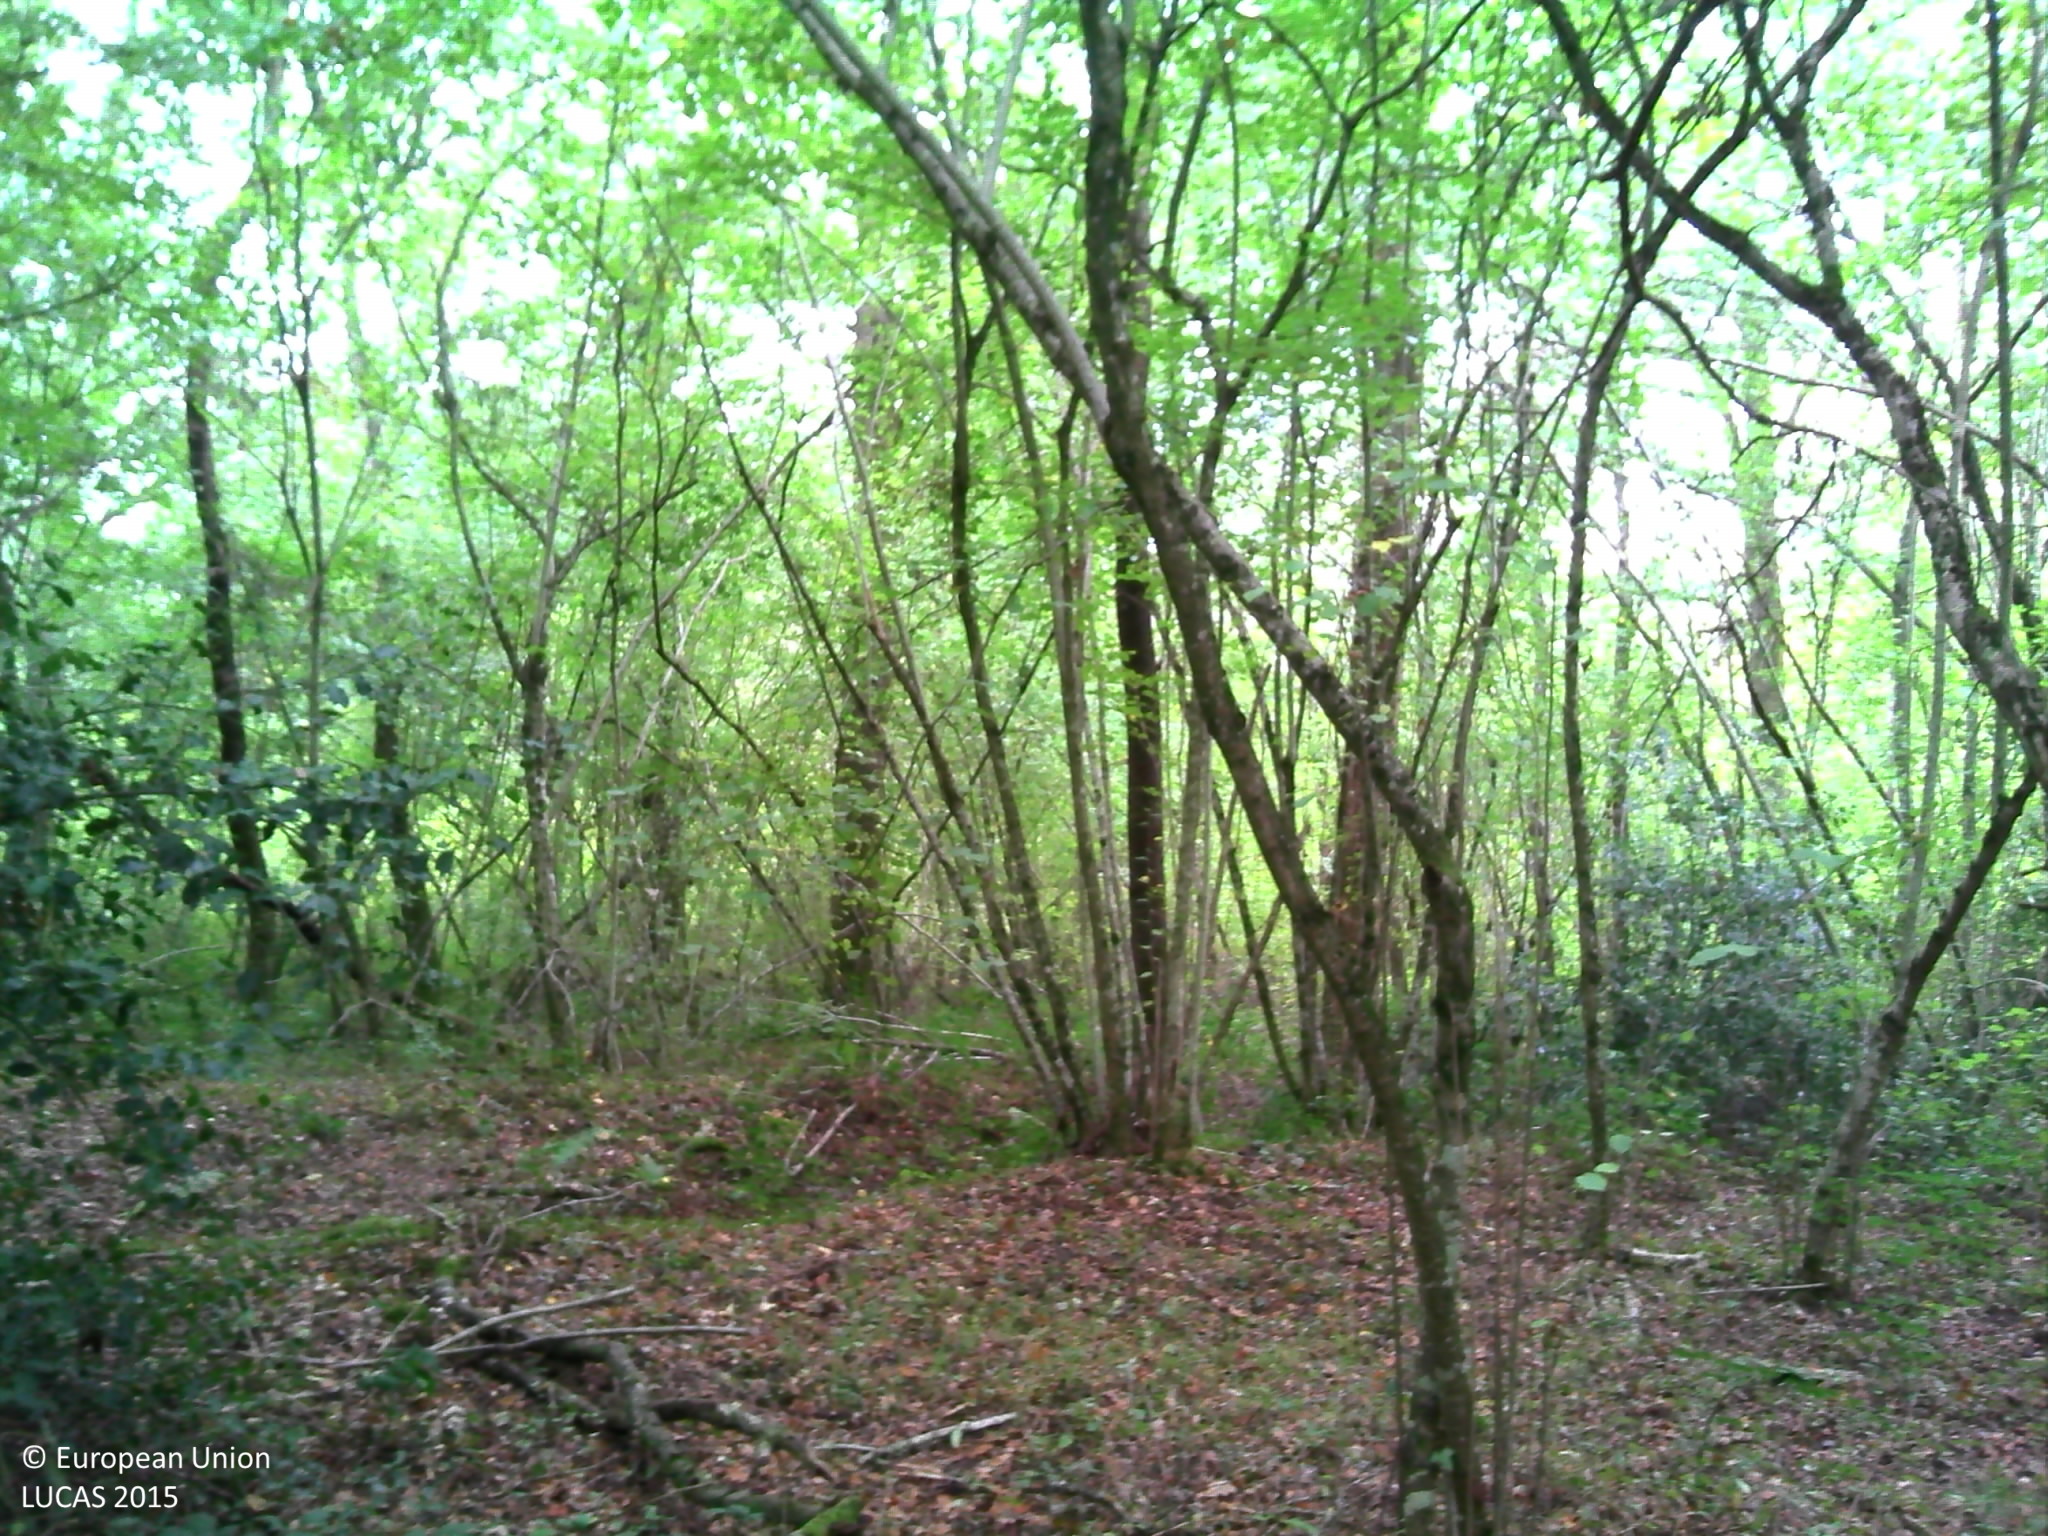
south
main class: Woodland
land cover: Broadleaved woodland
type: mesophytic deciduous forest
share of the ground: > 75 %
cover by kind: broadleaved forest trees 90 %, herbaceous plants 10 %
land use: Forestry
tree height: > 5 m
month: October
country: FR
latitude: 46.2755
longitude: 5.1104
